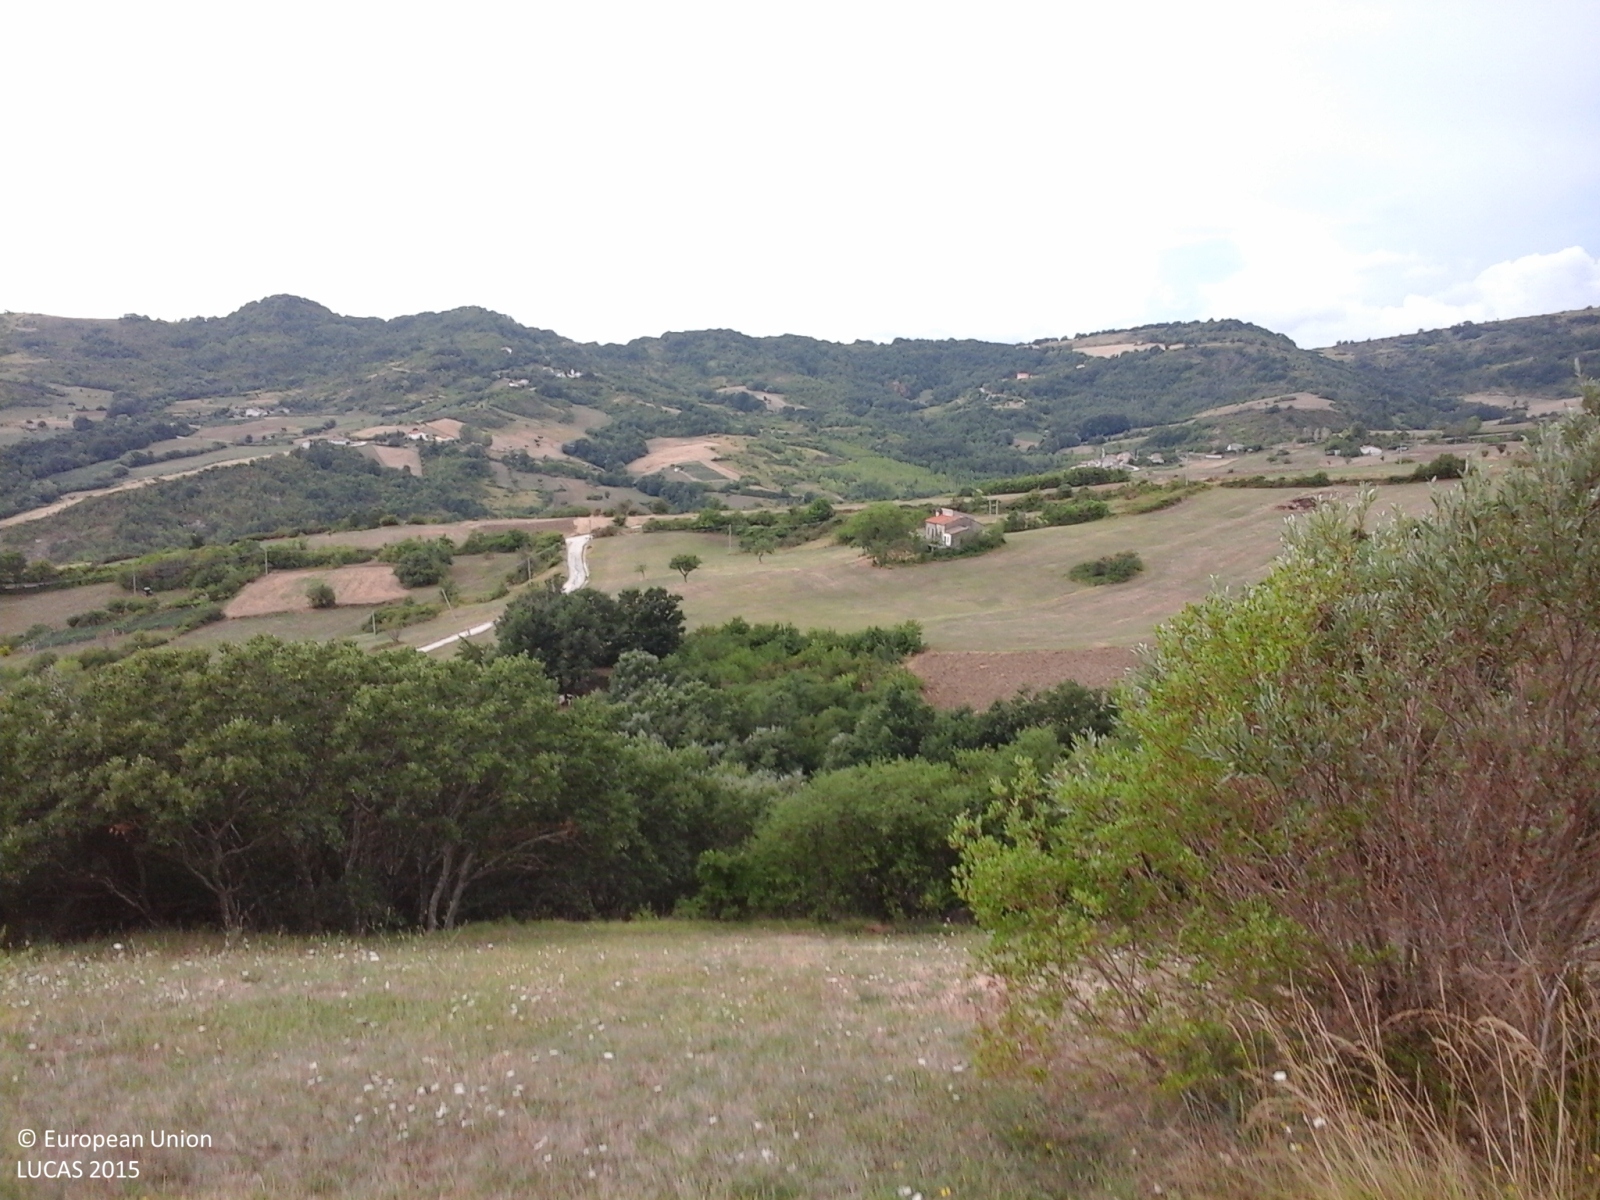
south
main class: Cropland
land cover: Temporary grasslands
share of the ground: > 75 %
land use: Agriculture (excluding fallow land and kitchen gardens)
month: August
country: IT
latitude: 41.8346
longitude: 14.4045
